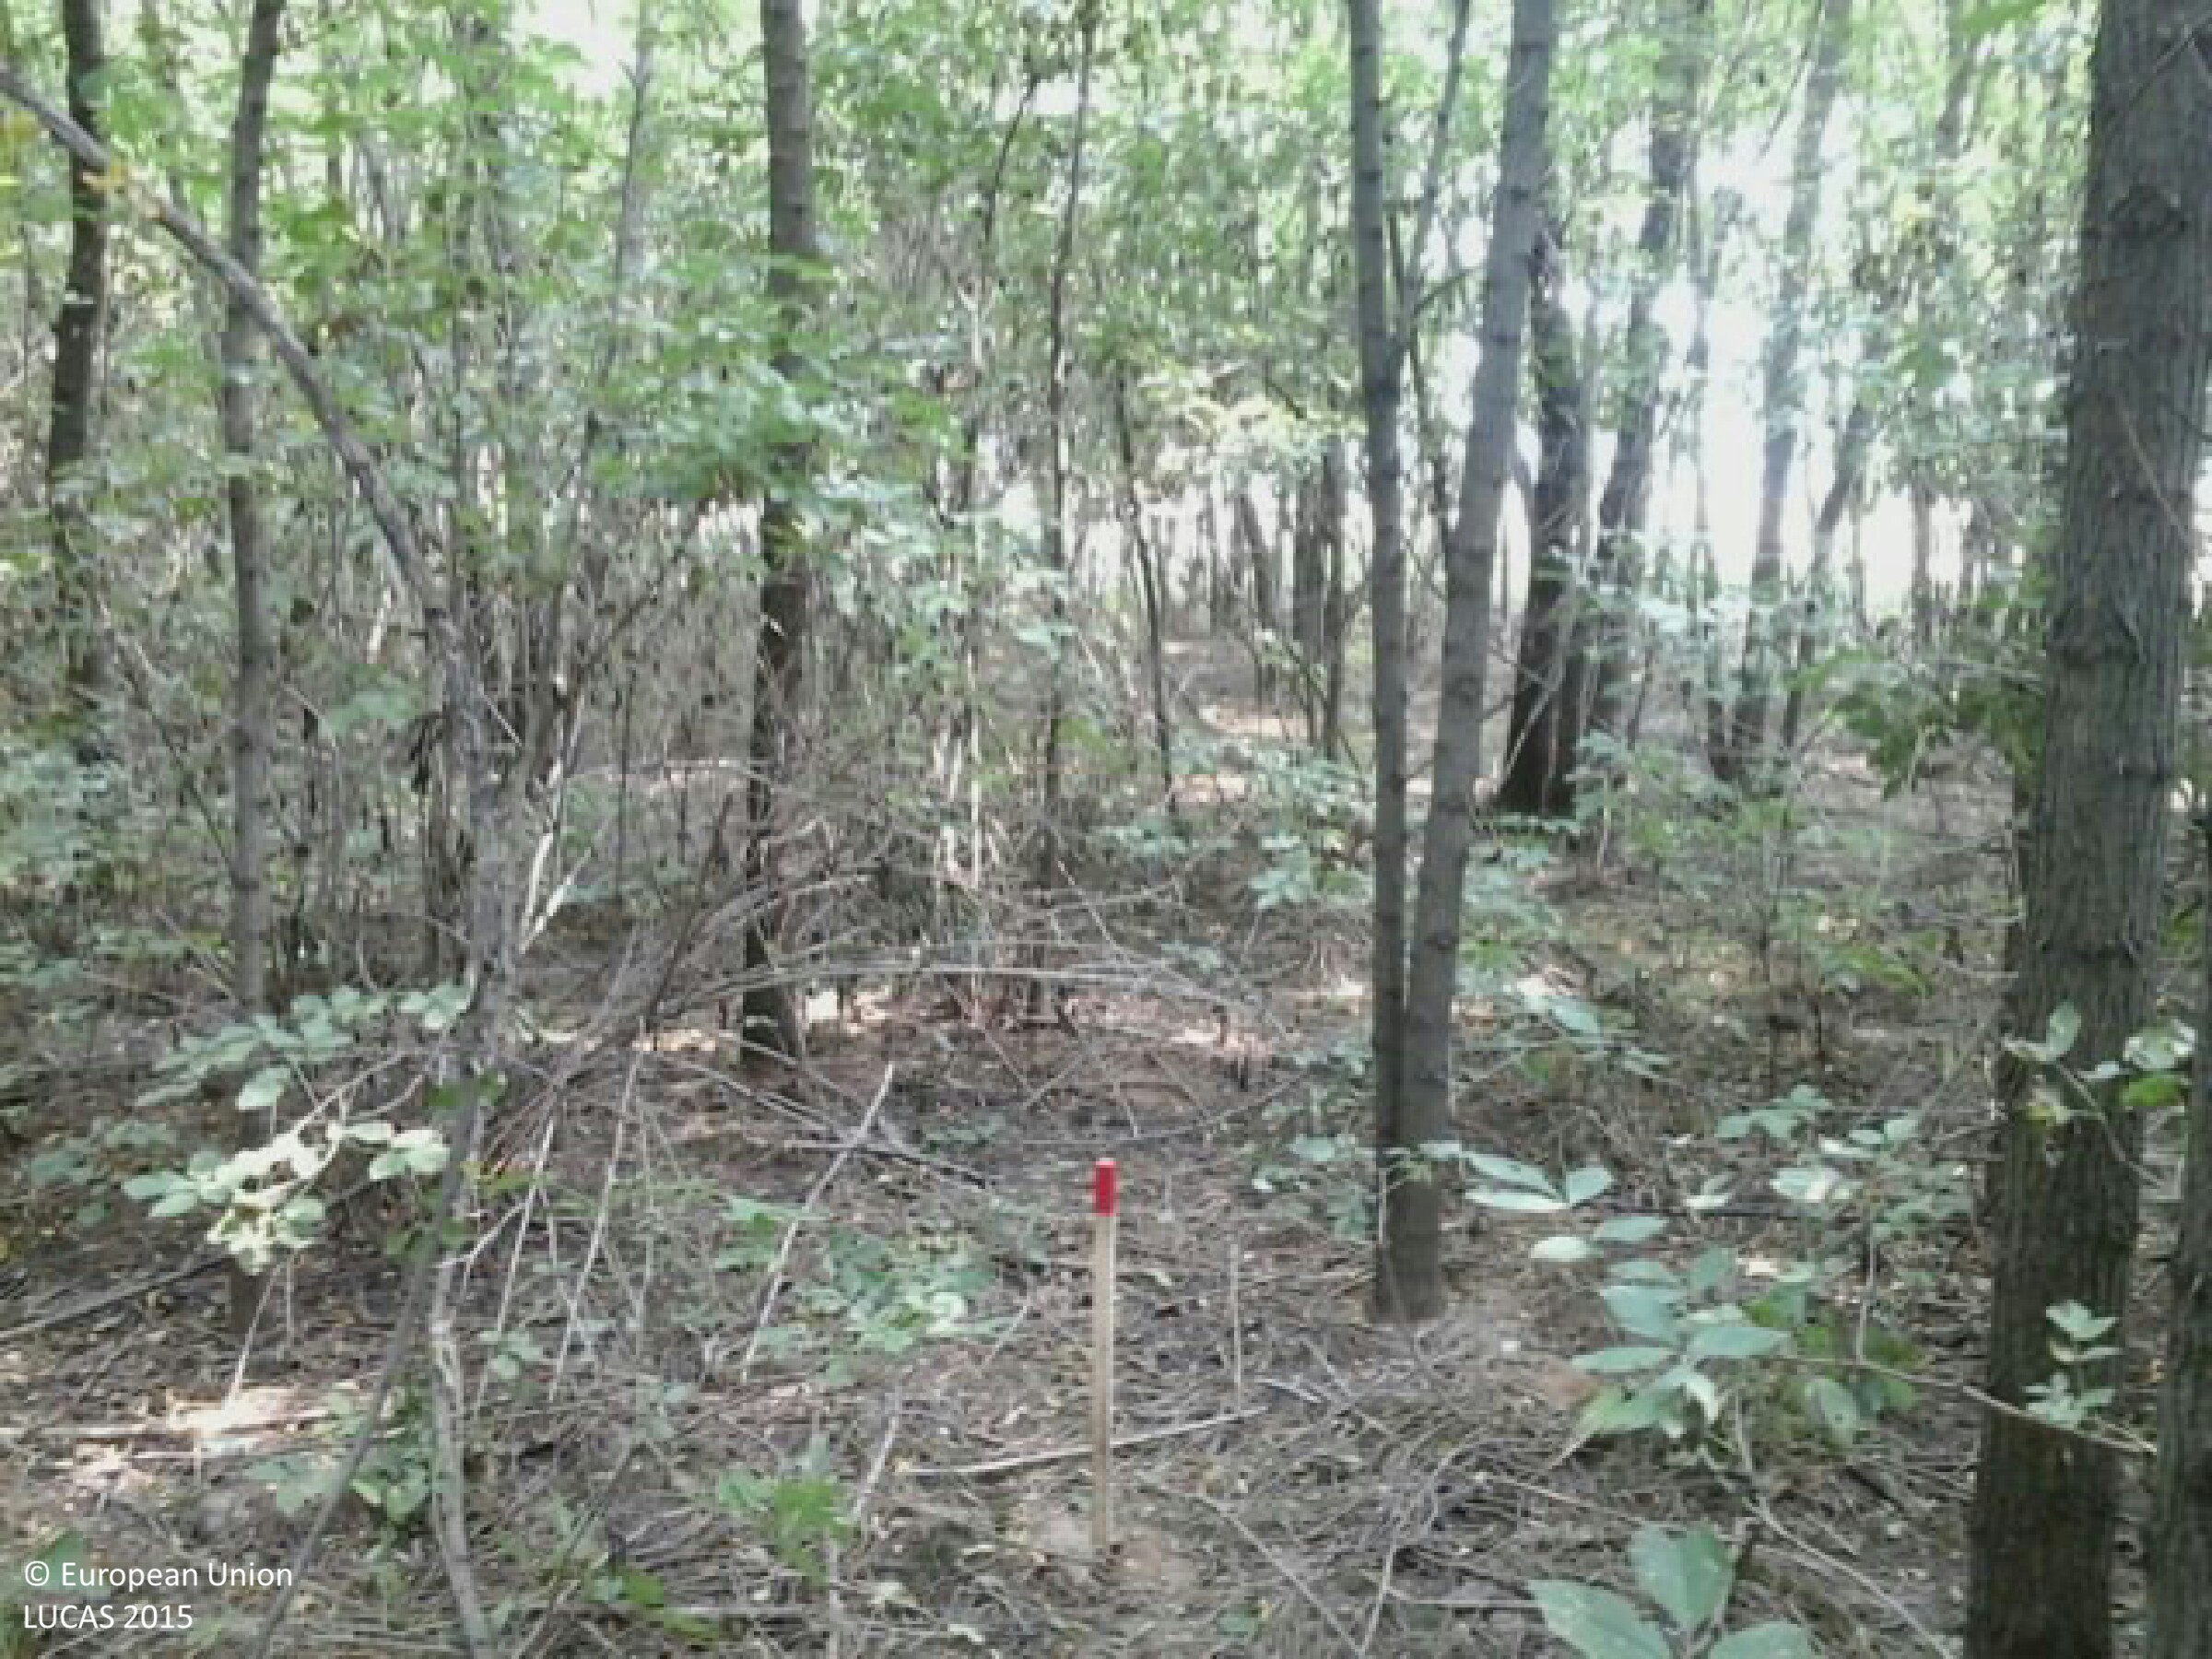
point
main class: Woodland
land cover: Broadleaved woodland
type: exotic forest
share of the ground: > 75 %
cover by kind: broadleaved forest trees 90 %, shrubs 5 %, herbaceous plants 5 %
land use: Forestry
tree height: > 5 m
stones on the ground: < 10 %
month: August
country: HU
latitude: 46.4145
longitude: 17.9821
